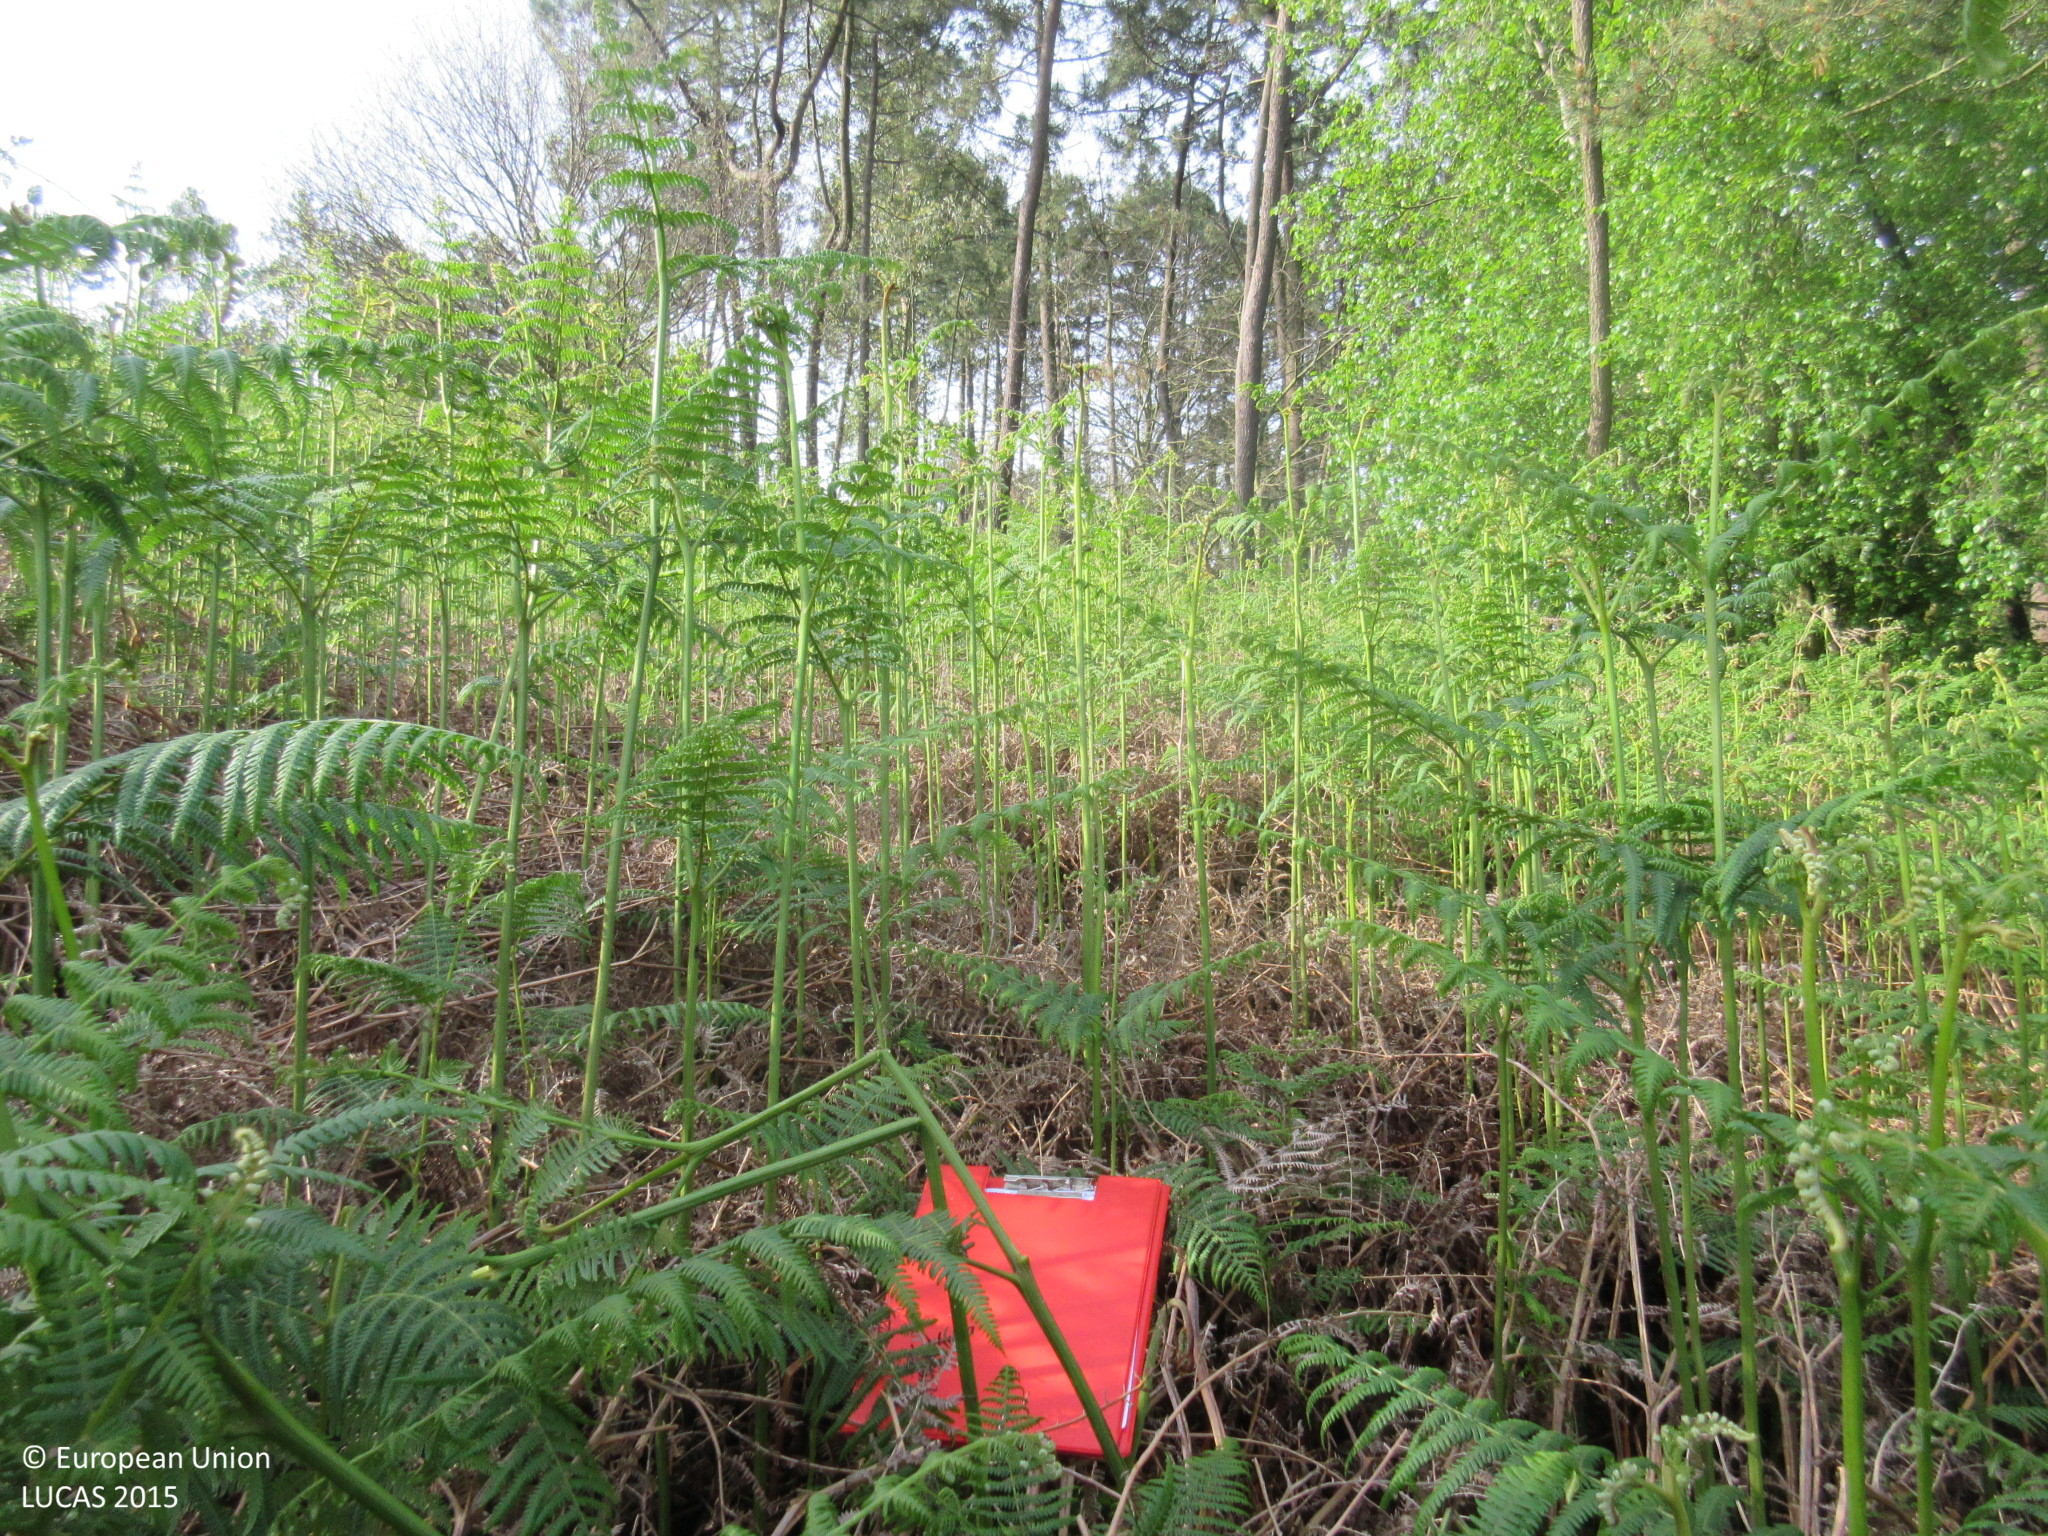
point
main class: Shrubland
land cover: Shrubland without tree cover
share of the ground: > 75 %
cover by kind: shrubs 100 %
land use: Semi-natural and natural areas not in use
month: April
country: ES
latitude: 43.5189
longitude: -6.6998
